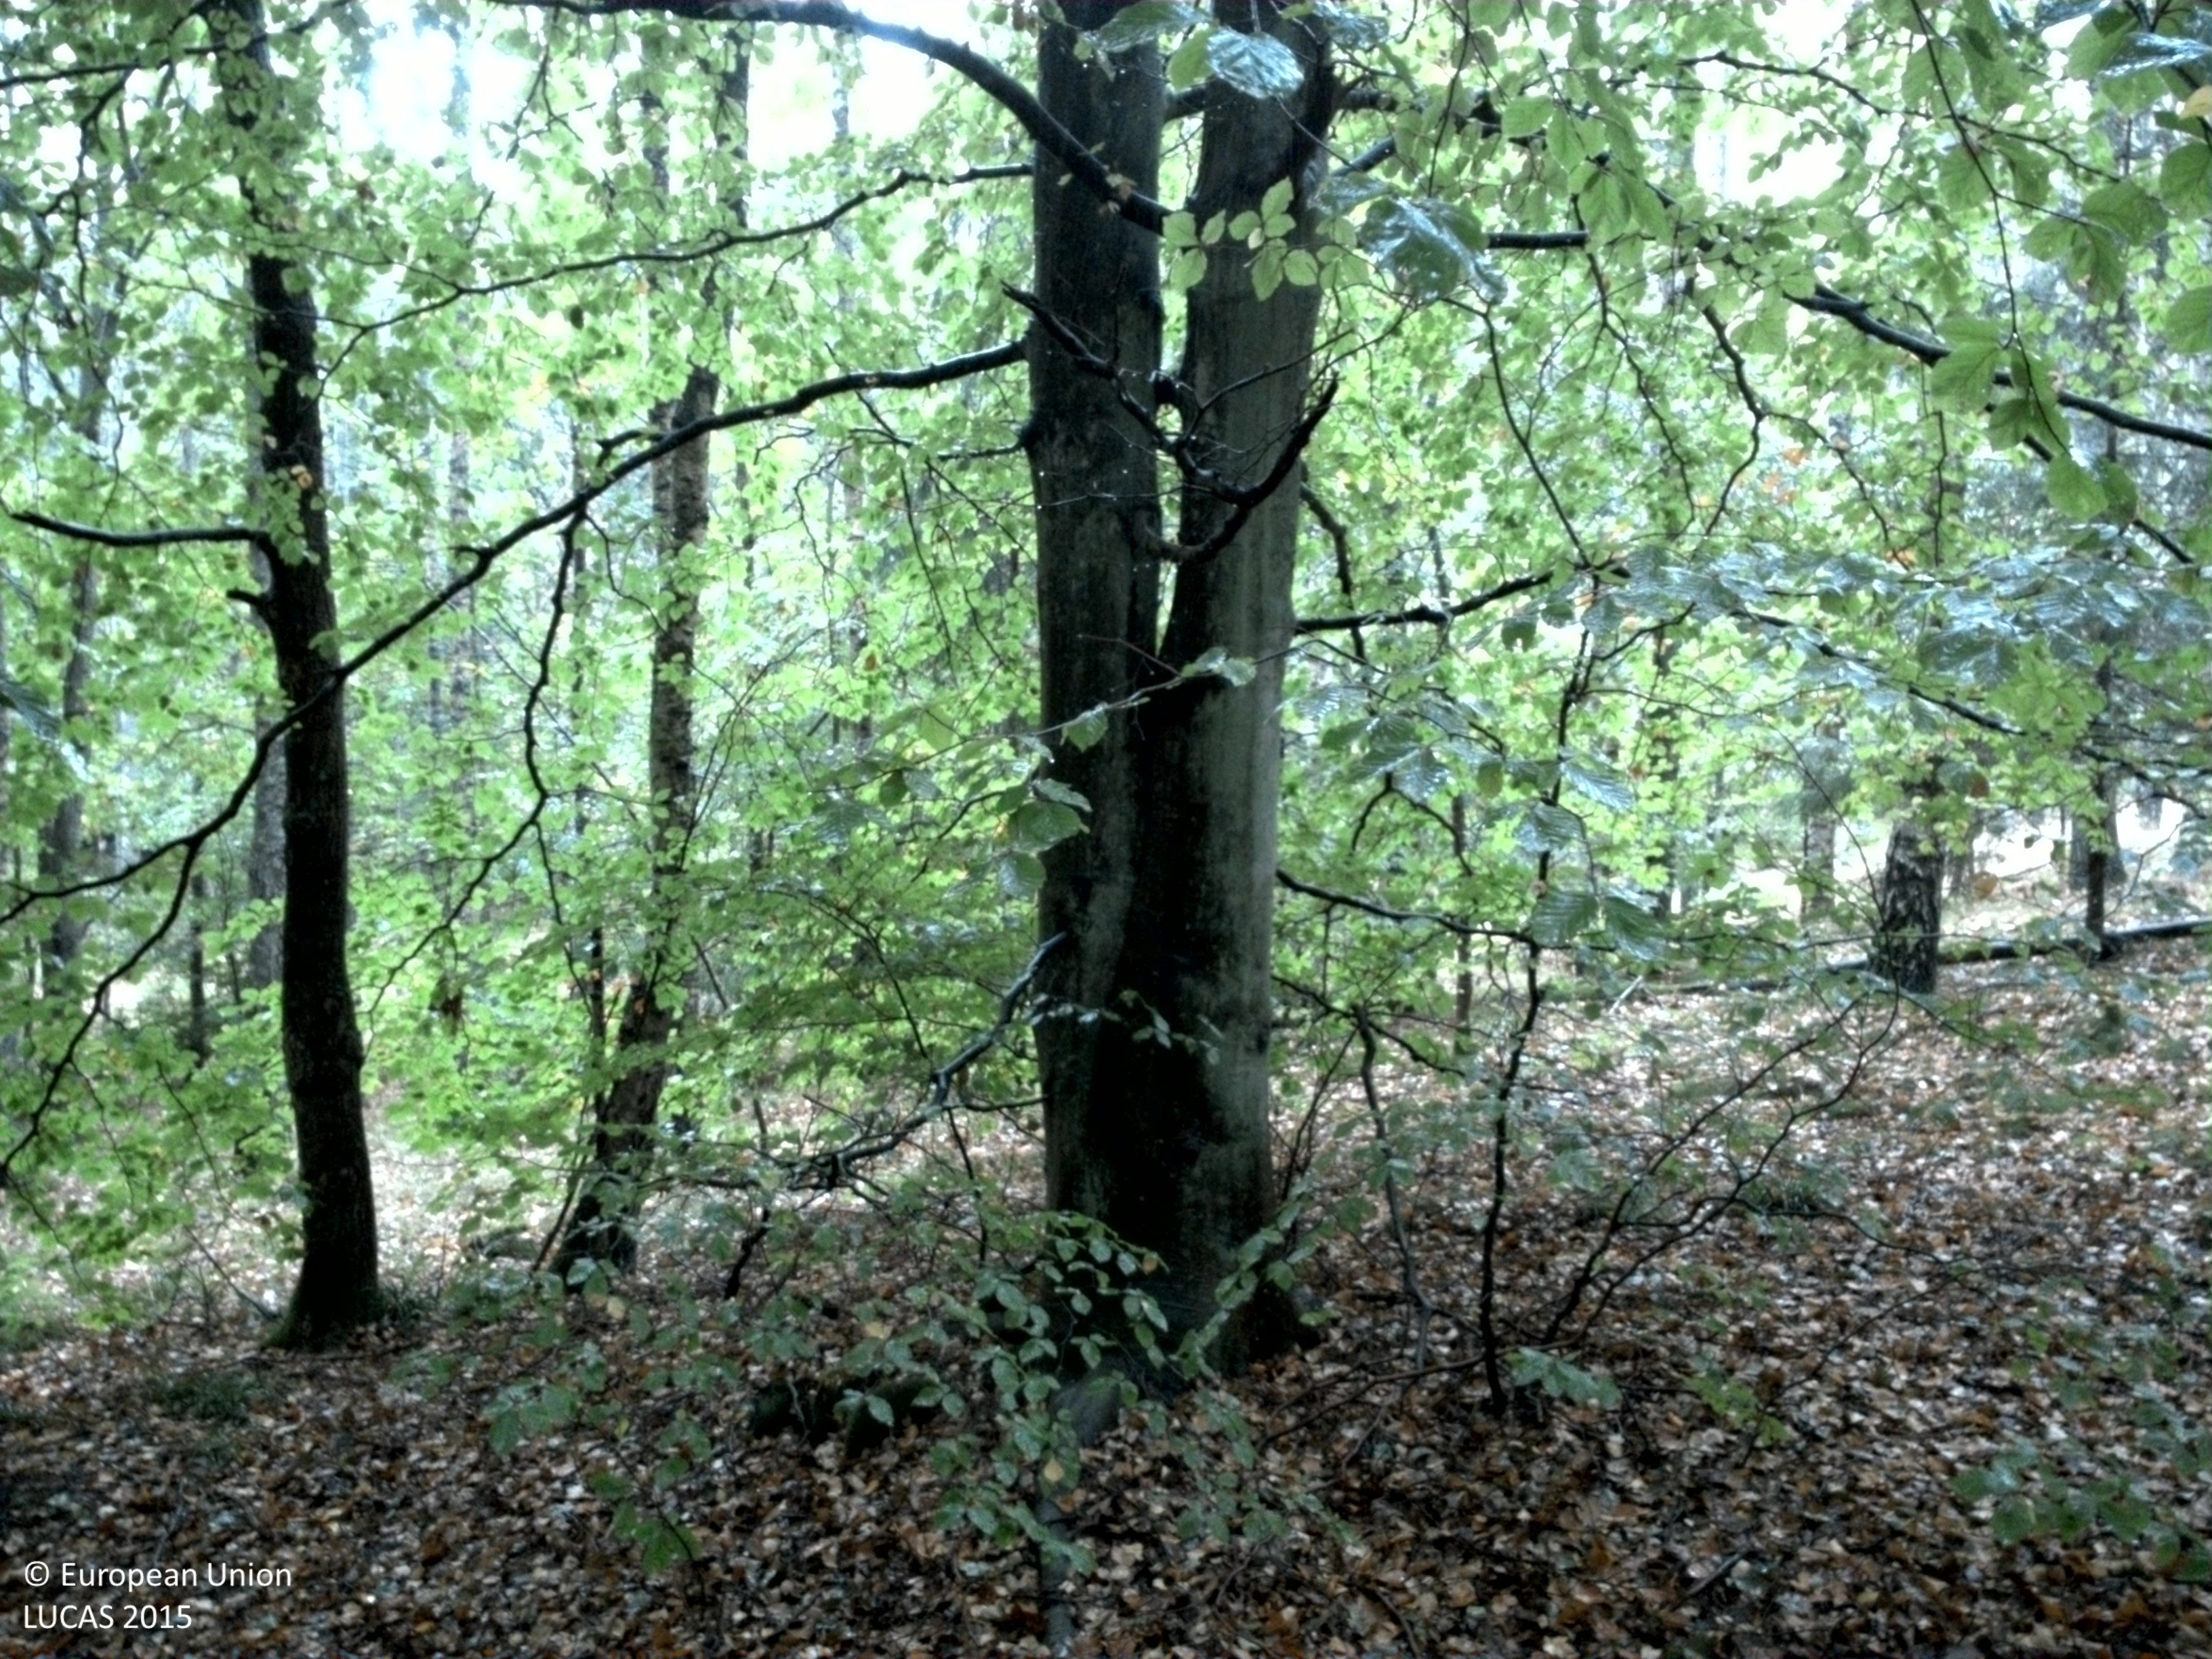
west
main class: Woodland
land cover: Broadleaved woodland
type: beech forest
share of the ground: > 75 %
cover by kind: broadleaved forest trees 80 %, unconsolidated bare surface 15 %, shrubs 5 %
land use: Forestry
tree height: > 5 m
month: October
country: SE
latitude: 55.7276
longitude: 14.0586
